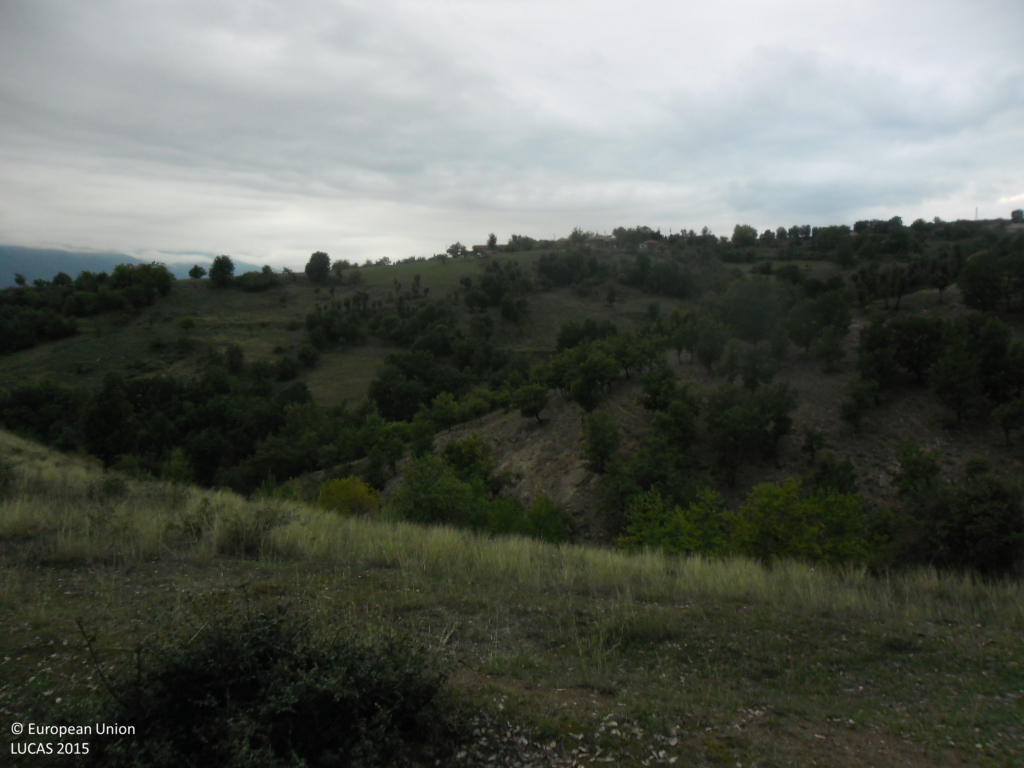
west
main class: Grassland
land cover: Grassland with sparse tree/shrub cover
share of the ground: > 75 %
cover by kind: herbaceous plants 90 %, broadleaved forest trees 5 %, shrubs 5 %
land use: Agriculture (excluding fallow land and kitchen gardens)
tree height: < 5 m
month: September
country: BG
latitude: 41.4223
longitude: 23.0474
